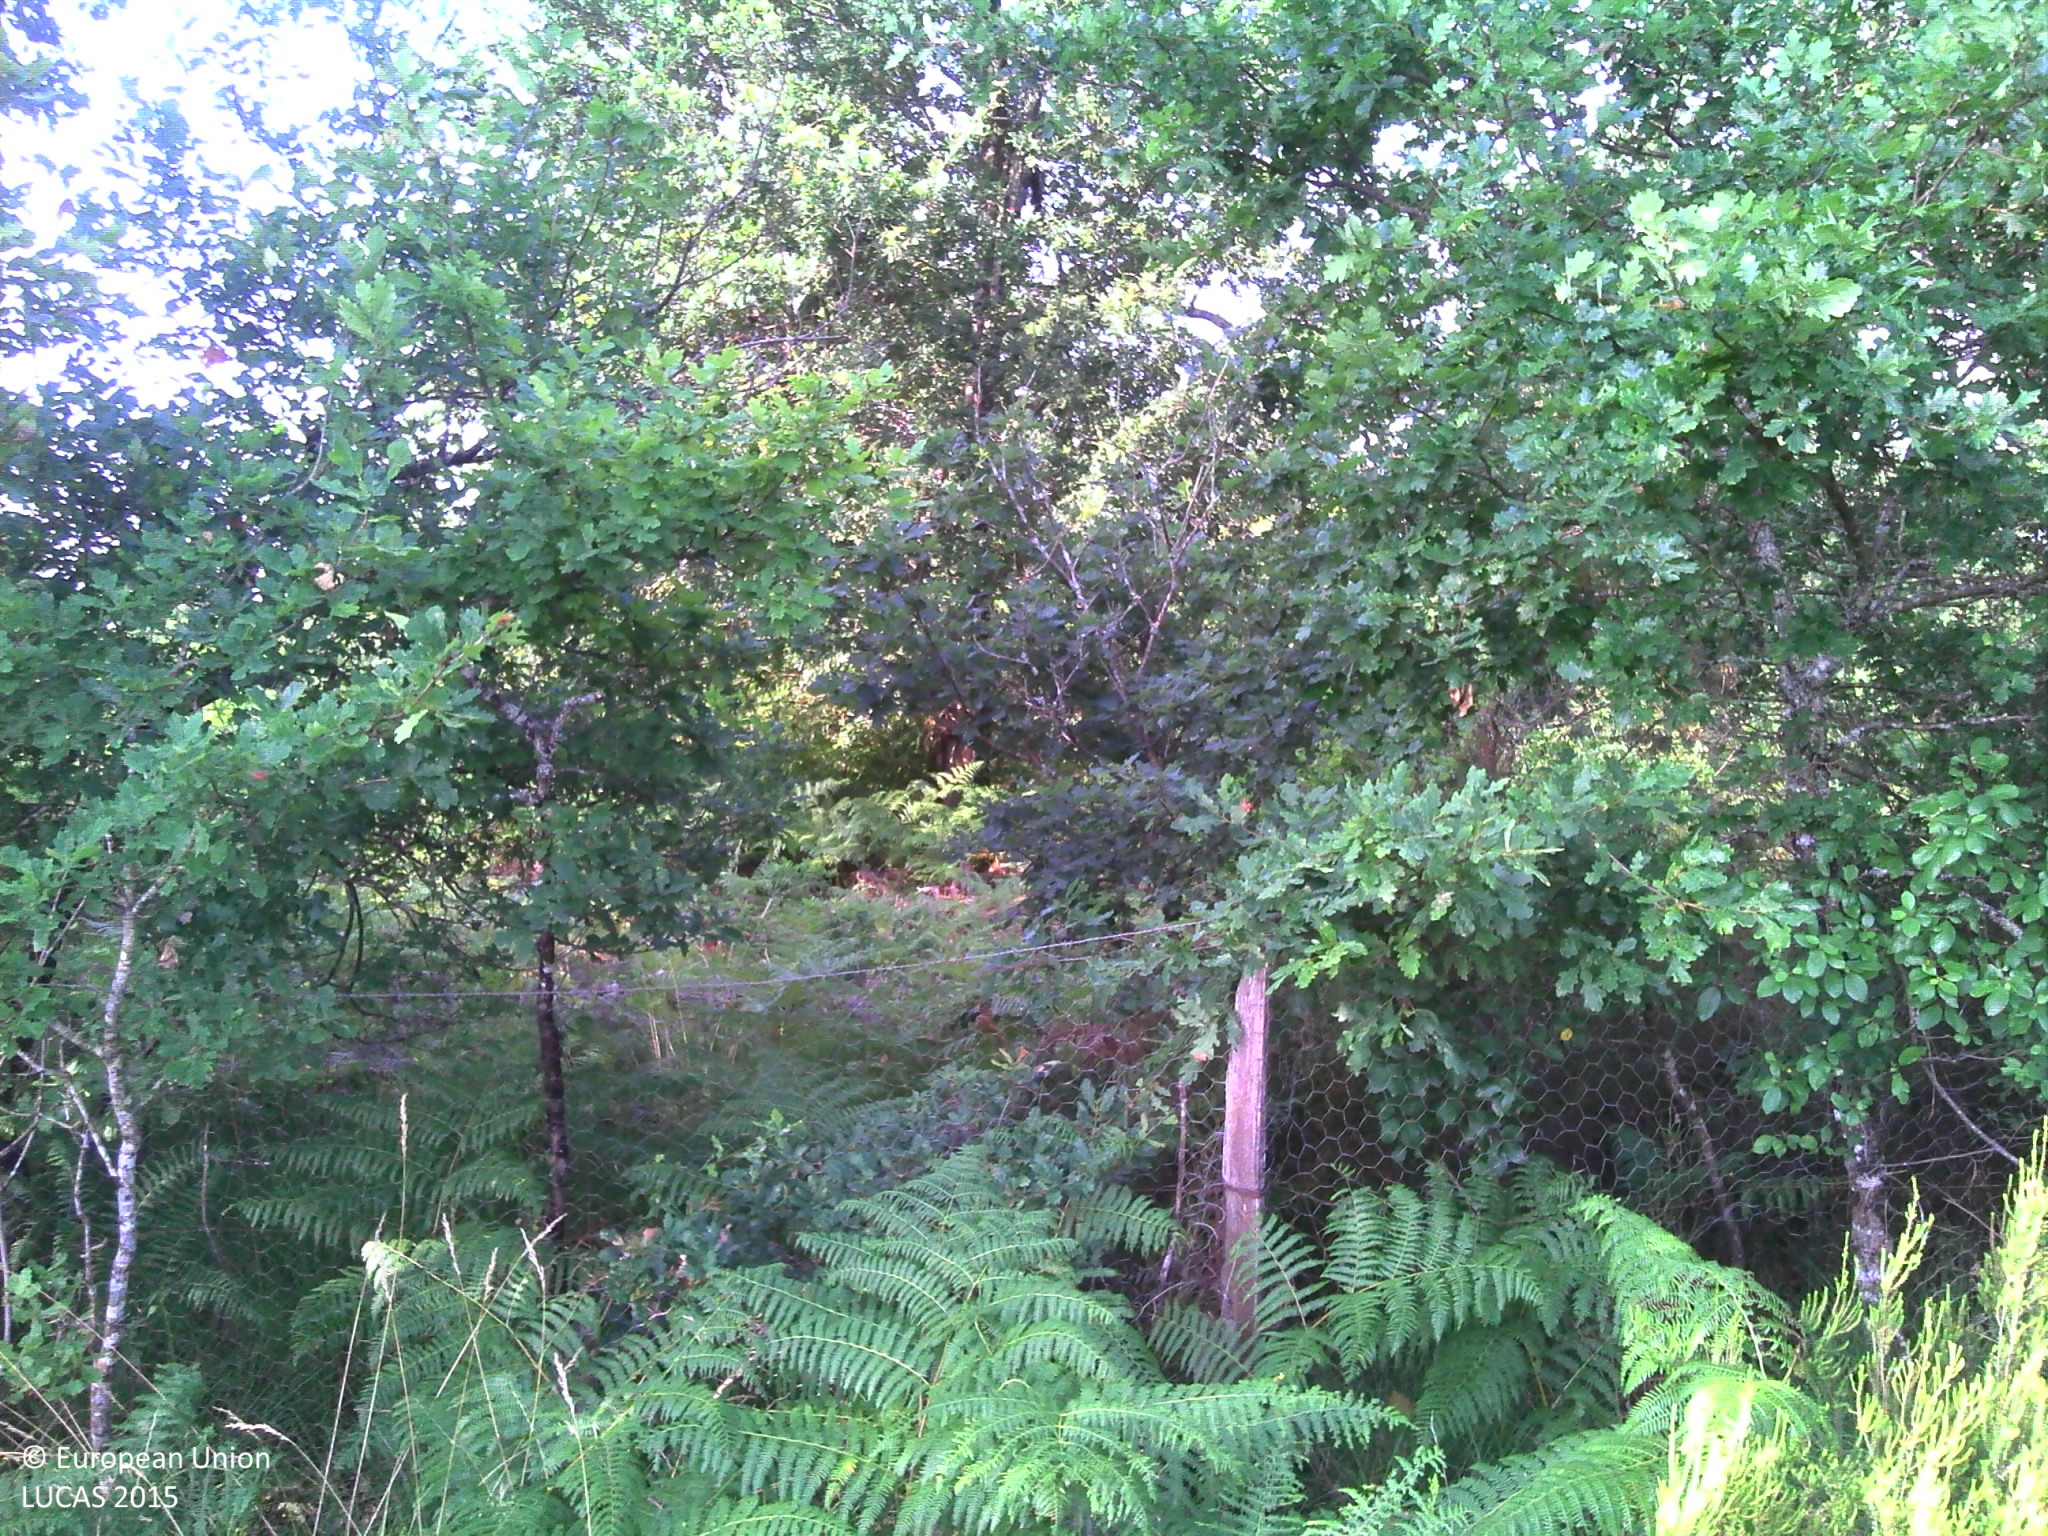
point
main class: Woodland
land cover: Broadleaved woodland
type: thermophilous deciduous forest
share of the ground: 50 - 75 %
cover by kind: broadleaved forest trees 75 %, herbaceous plants 15 %, coniferous forest trees 10 %
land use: Forestry
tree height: > 5 m
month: July
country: FR
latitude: 44.1281
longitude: -0.6504
